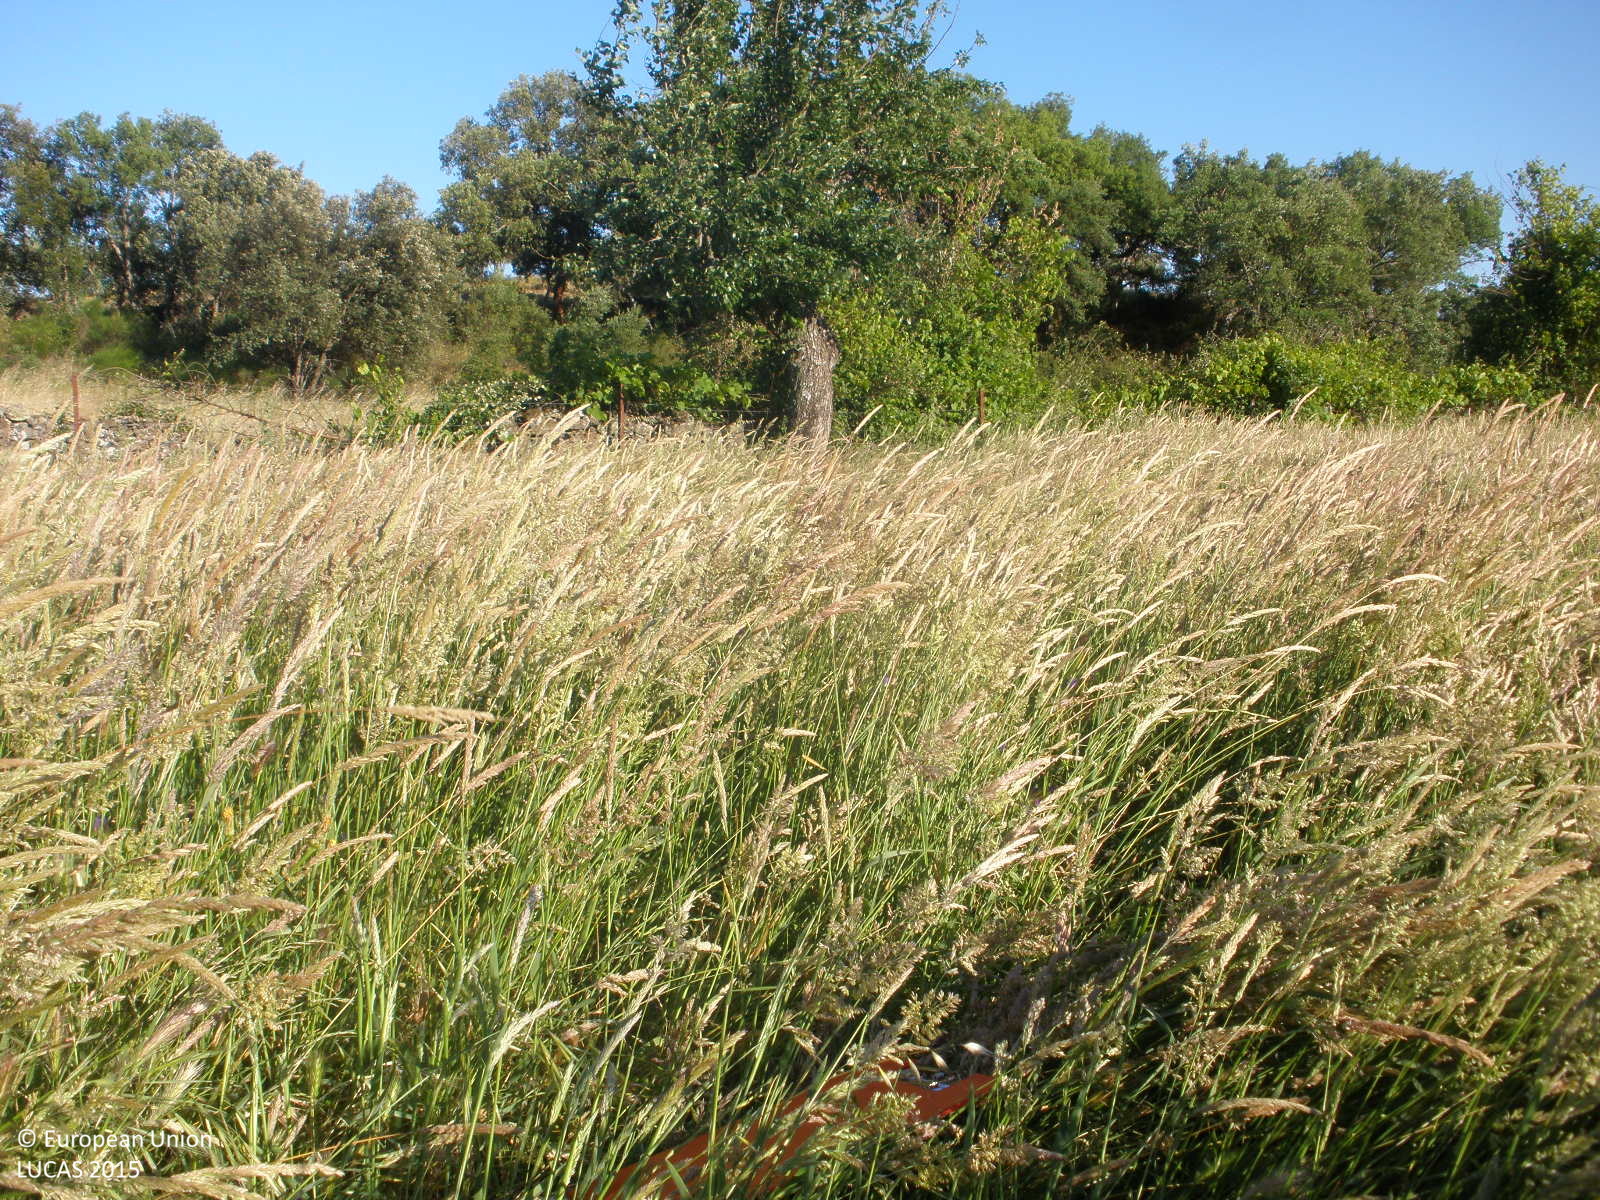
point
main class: Grassland
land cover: Spontaneously vegetated surfaces
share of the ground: > 75 %
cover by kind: herbaceous plants 100 %
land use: Fallow land
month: May
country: ES
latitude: 40.2337
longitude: -6.2147
